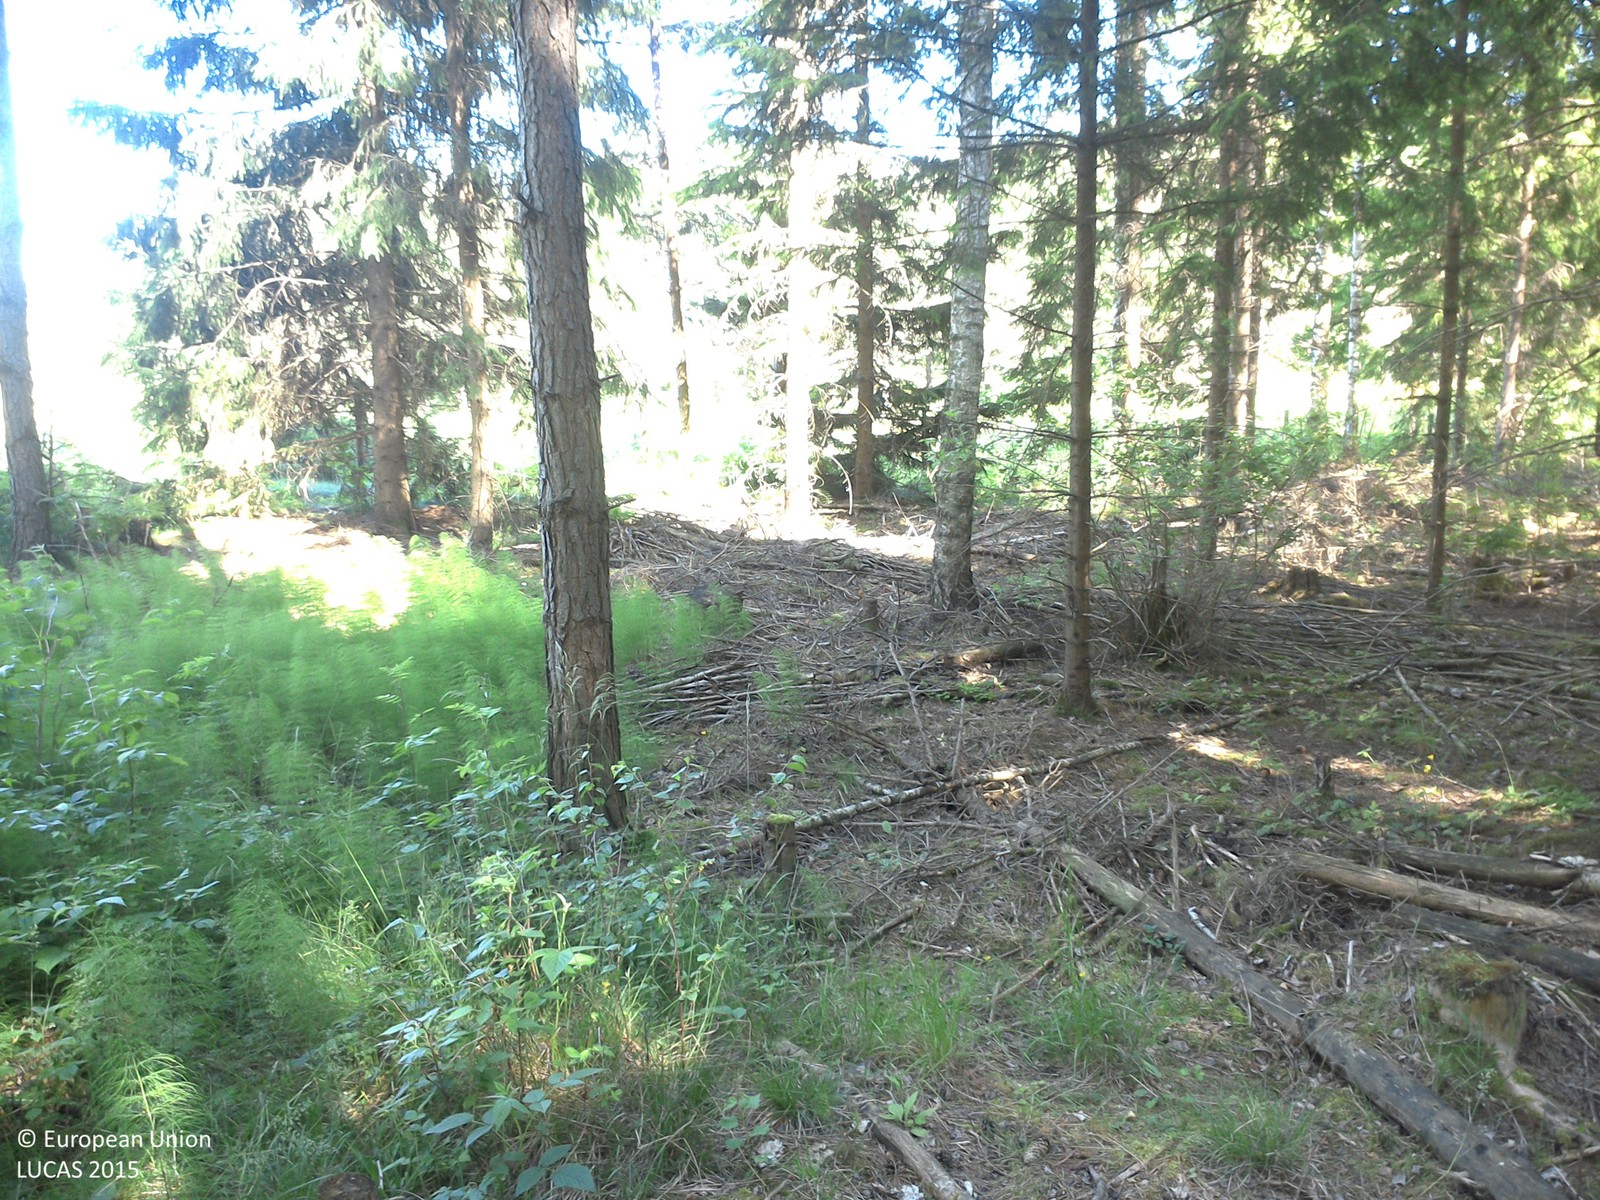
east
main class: Woodland
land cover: Spruce dominated coniferous woodland
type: boreal forest
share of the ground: > 75 %
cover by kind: coniferous forest trees 75 %, lichens and mosses 20 %, herbaceous plants 5 %
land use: Forestry
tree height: > 5 m
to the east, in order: Spruce dominated coniferous woodland; Grassland with sparse tree/shrub cover; Pine dominated coniferous woodland; Grassland without tree/shrub cover; Grassland with sparse tree/shrub cover; Rock outcrops; Electric lines; Rock outcrops; Grassland with sparse tree/shrub cover
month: July
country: SE
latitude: 58.3451
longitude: 15.4101
